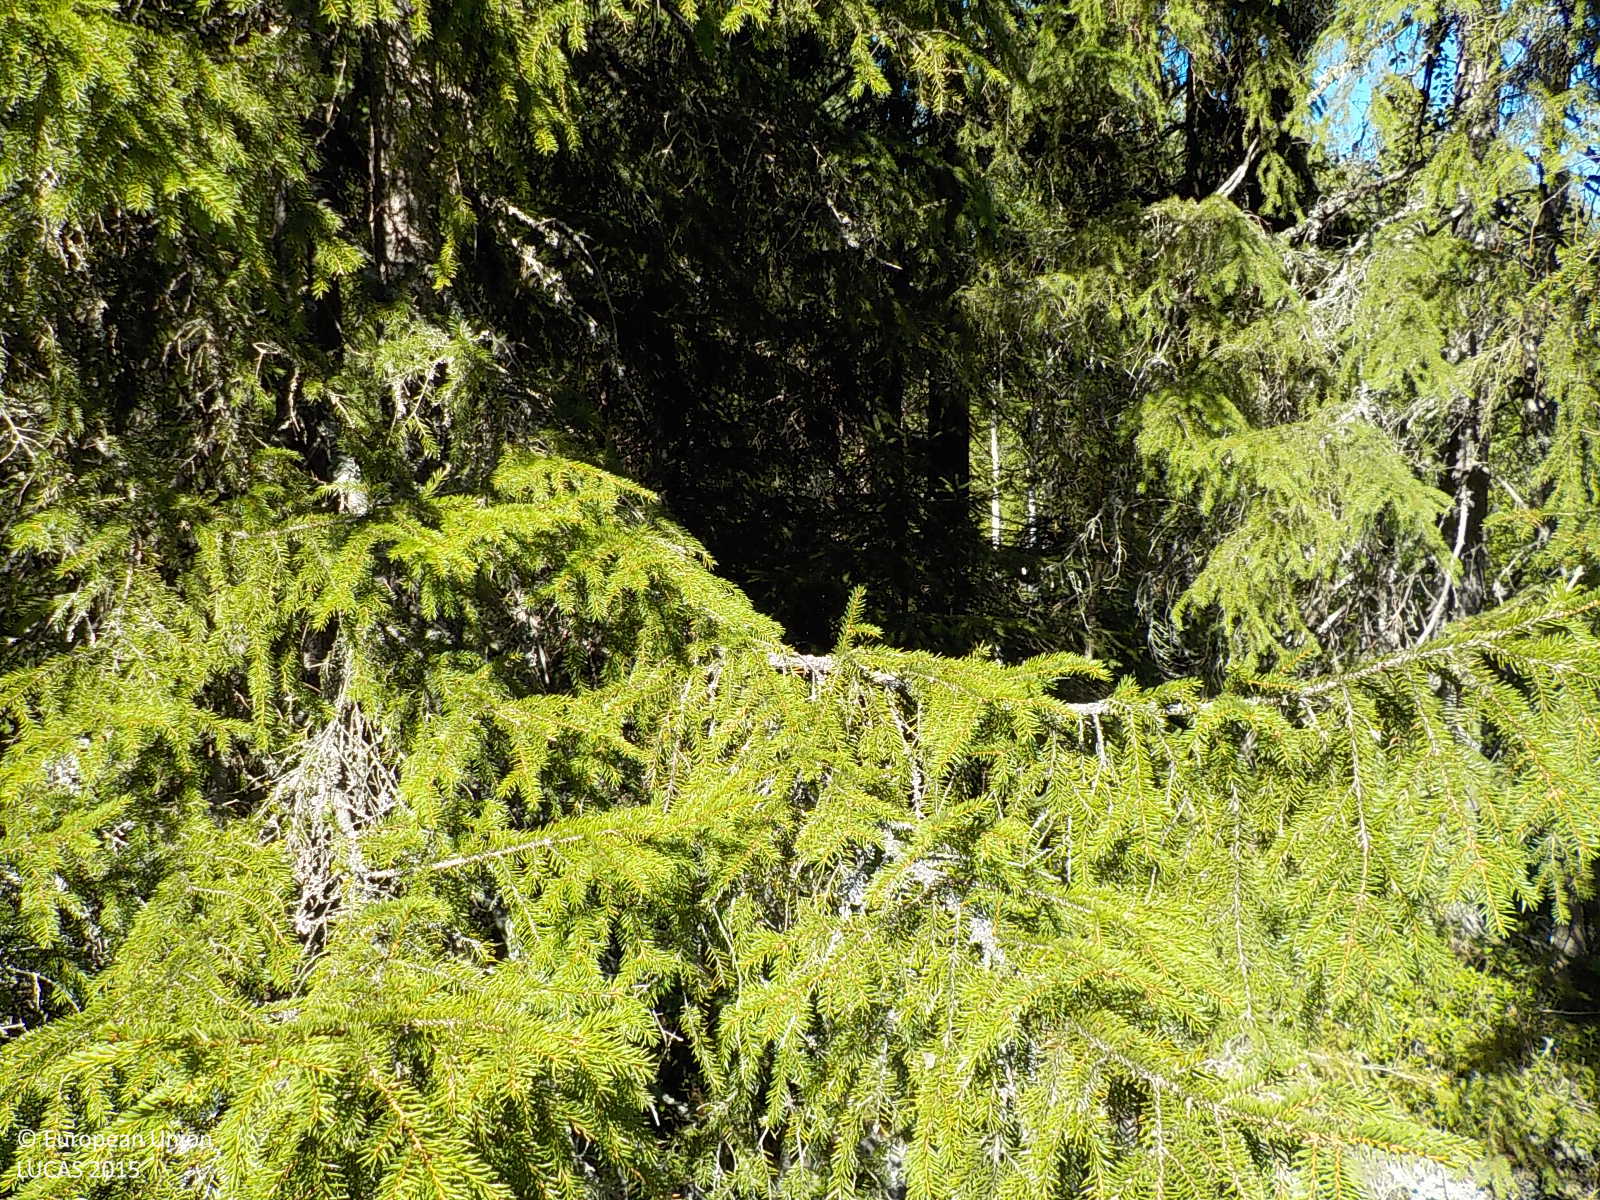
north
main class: Woodland
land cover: Spruce dominated mixed woodland
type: boreal forest
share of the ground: > 75 %
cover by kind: coniferous forest trees 60 %, broadleaved forest trees 20 %, herbaceous plants 20 %
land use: Forestry
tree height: > 5 m
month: August
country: SE
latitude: 63.3408
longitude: 18.7077
